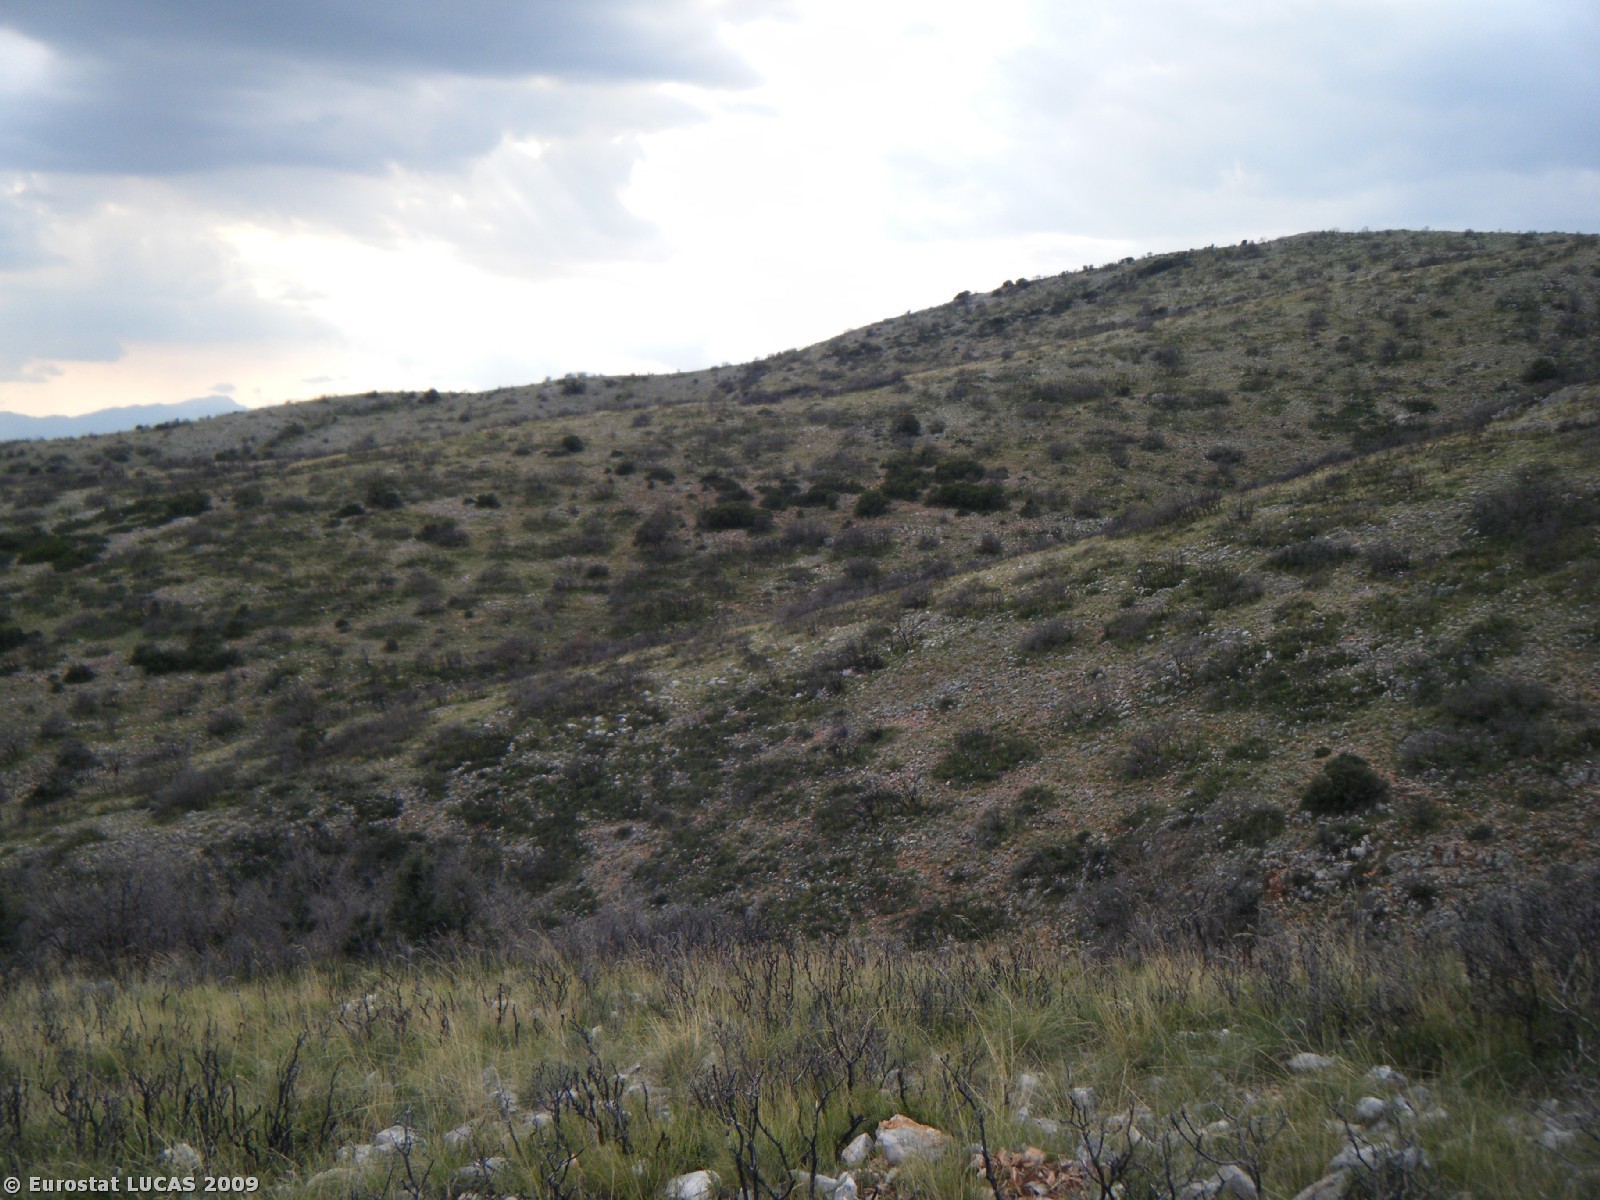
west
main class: Grassland
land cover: Grassland with sparse tree/shrub cover
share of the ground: 50 - 75 %
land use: Unused
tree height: < 5 m
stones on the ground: 25 - 50 %
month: October
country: GR
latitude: 37.4682
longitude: 22.2281
